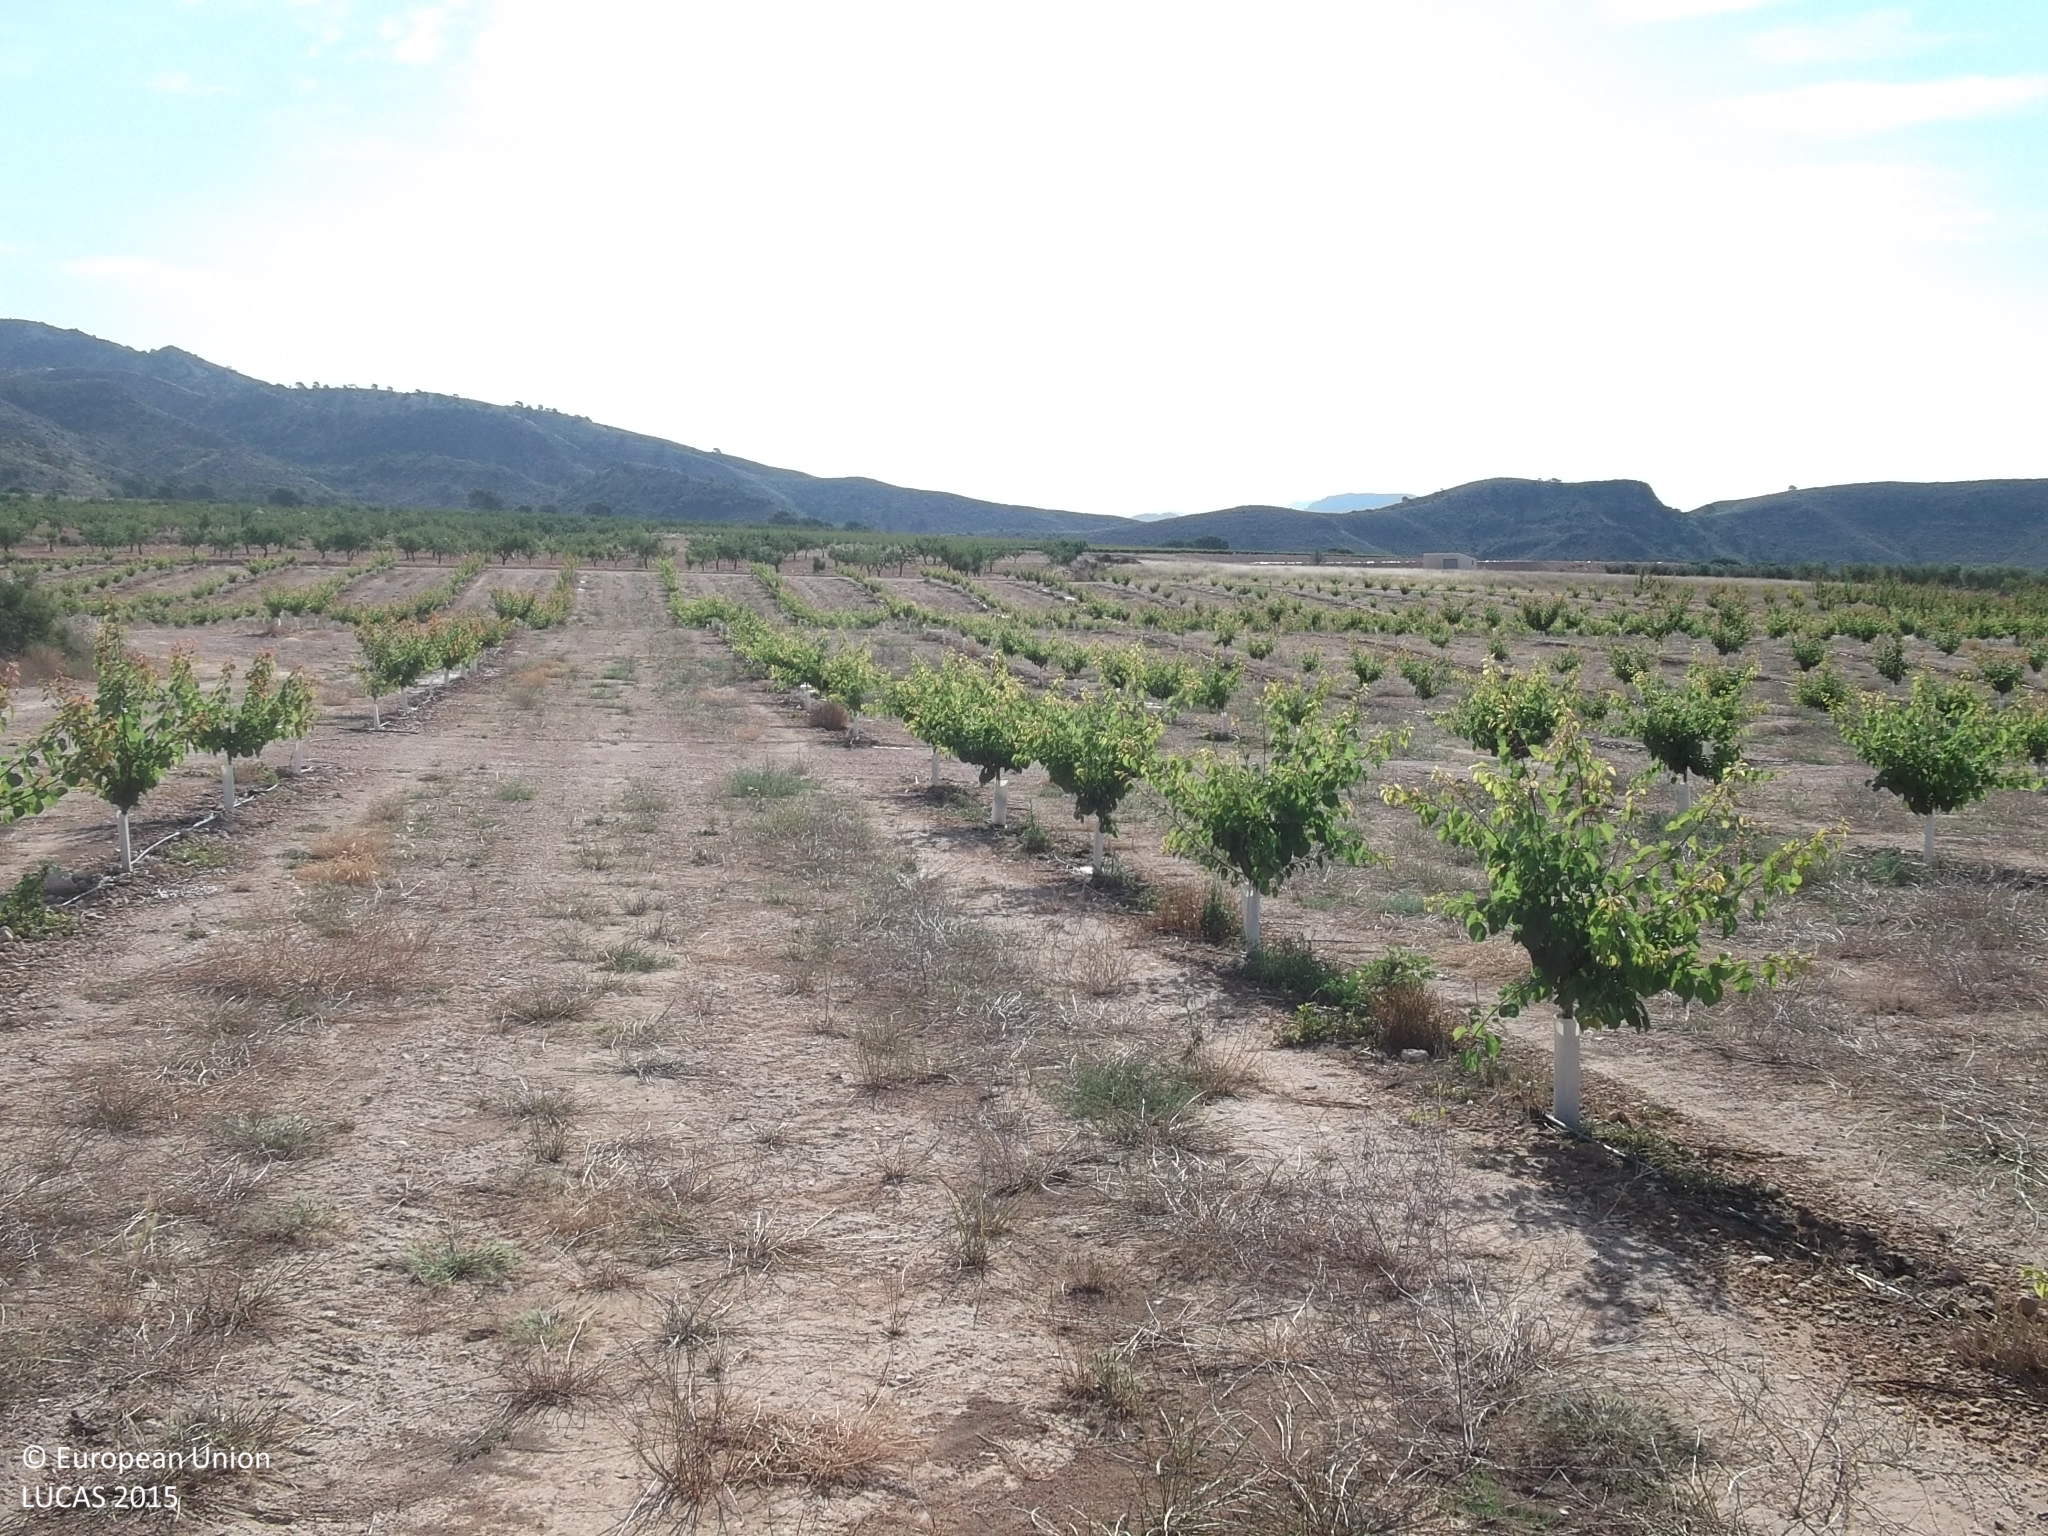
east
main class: Cropland
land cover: Other fruit trees and berries
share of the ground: 10 - 25 %
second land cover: Spontaneously vegetated surfaces
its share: > 75 %
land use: Agriculture (excluding fallow land and kitchen gardens)
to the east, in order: Other fruit trees and berries; Spontaneously vegetated surfaces; Tracks; Other fruit trees and berries; Tracks; Grassland without tree/shrub cover
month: June
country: ES
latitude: 38.4246
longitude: -1.4567
